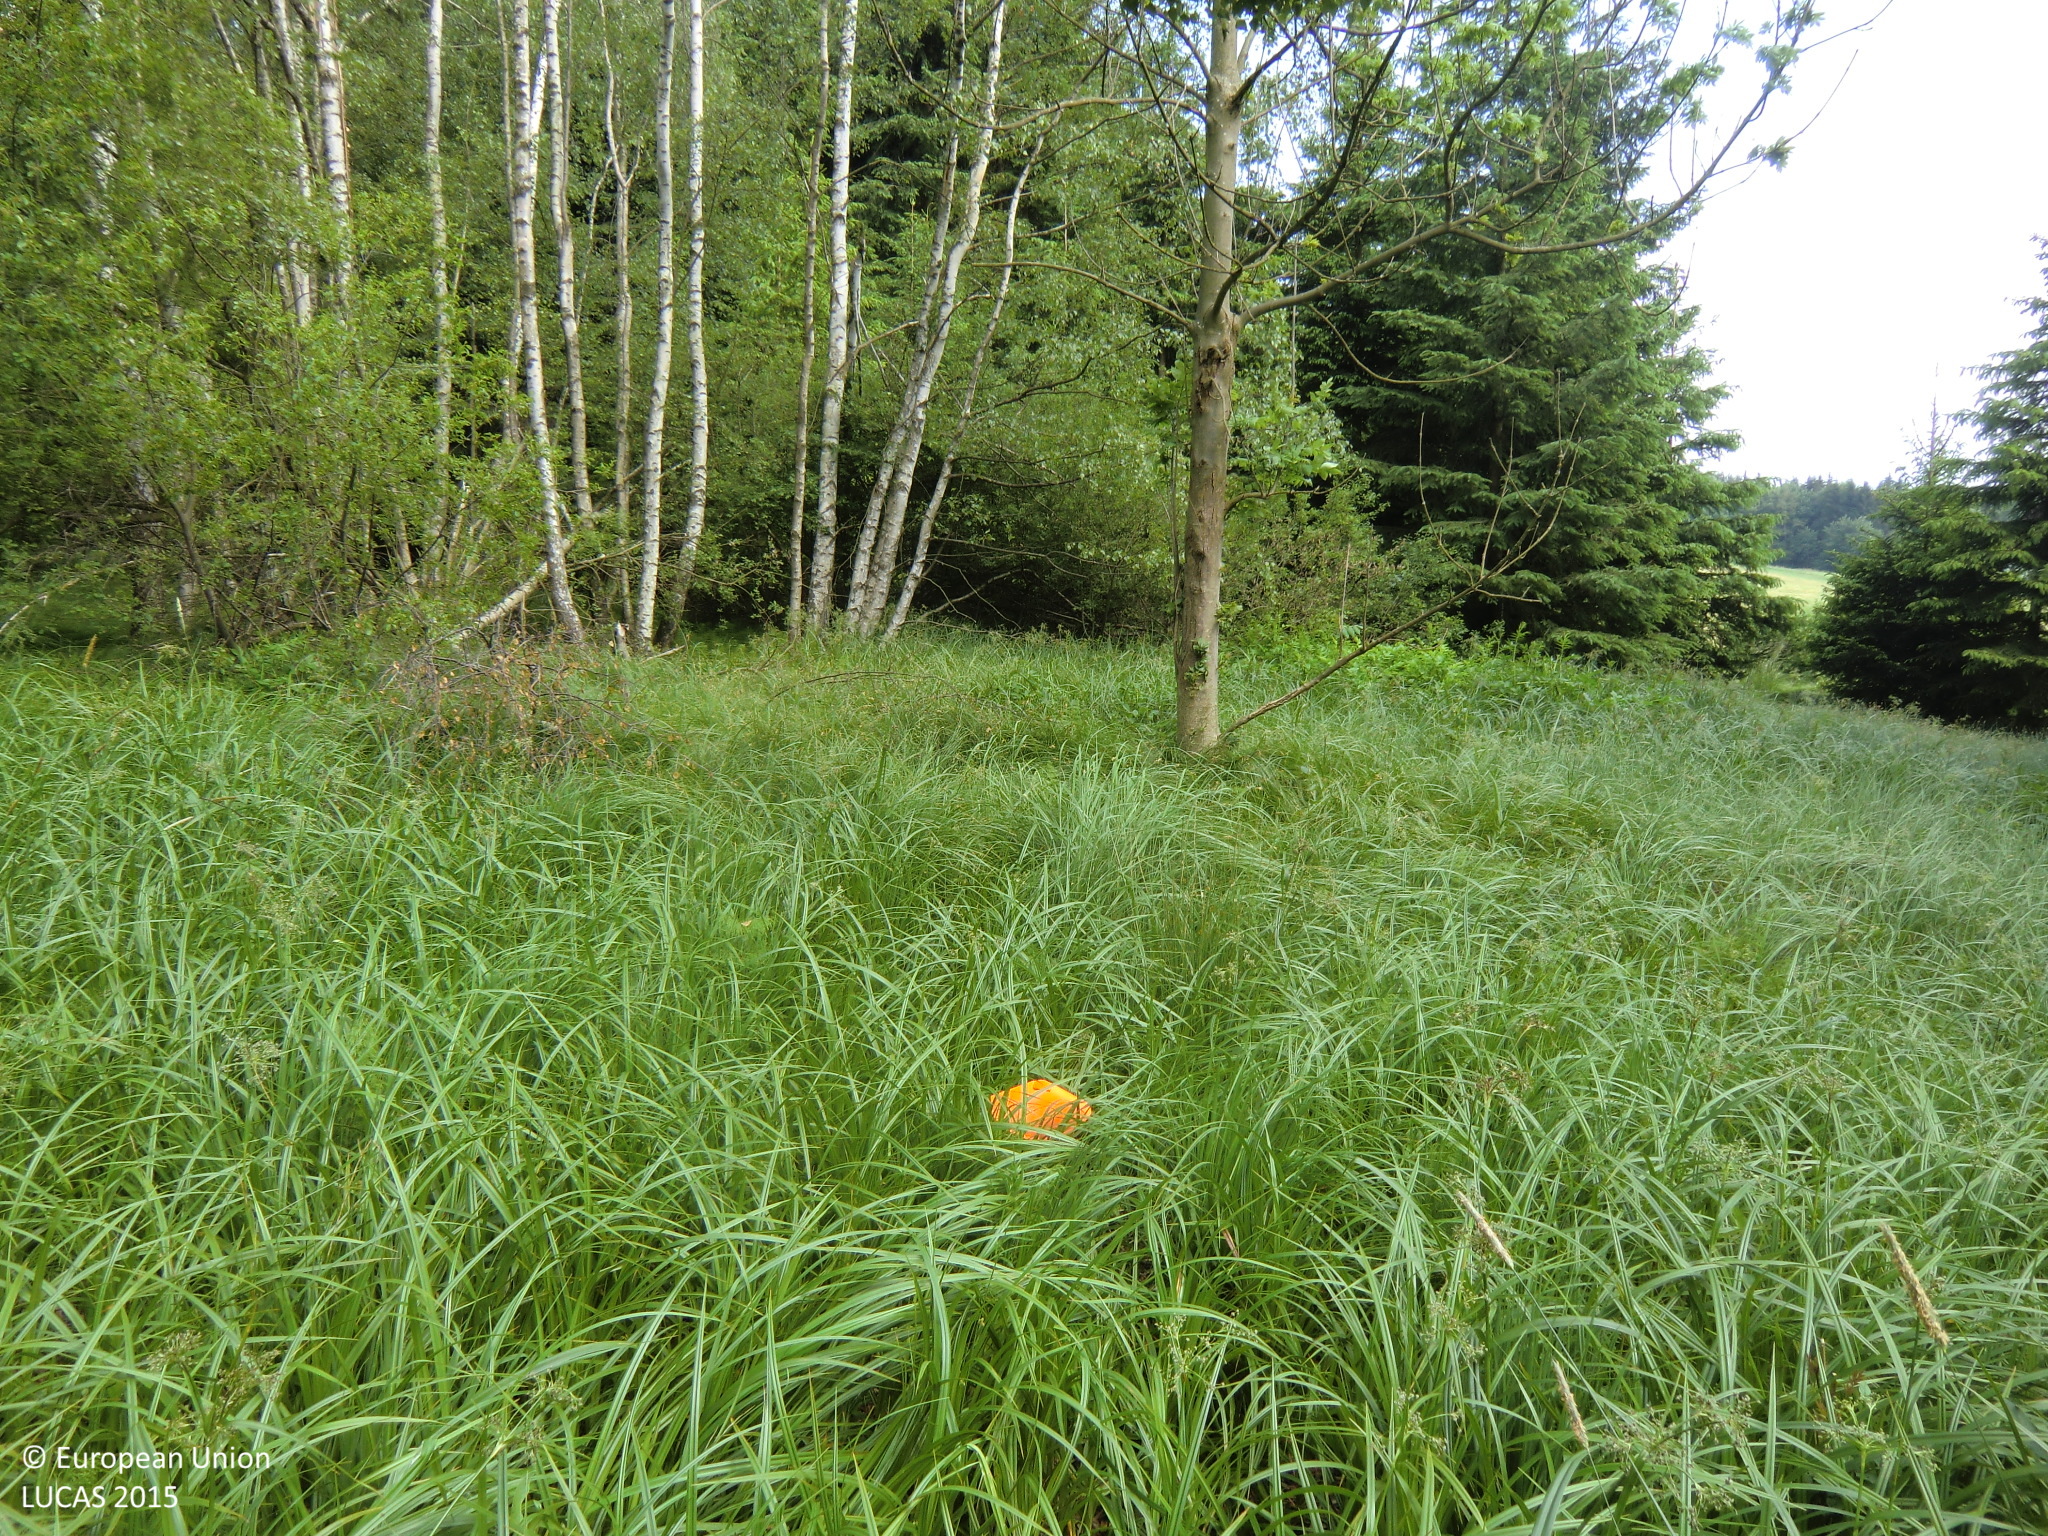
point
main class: Grassland
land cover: Spontaneously vegetated surfaces
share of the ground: > 75 %
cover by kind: herbaceous plants 100 %
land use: Abandoned areas
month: June
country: AT
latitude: 48.7139
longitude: 14.7991
